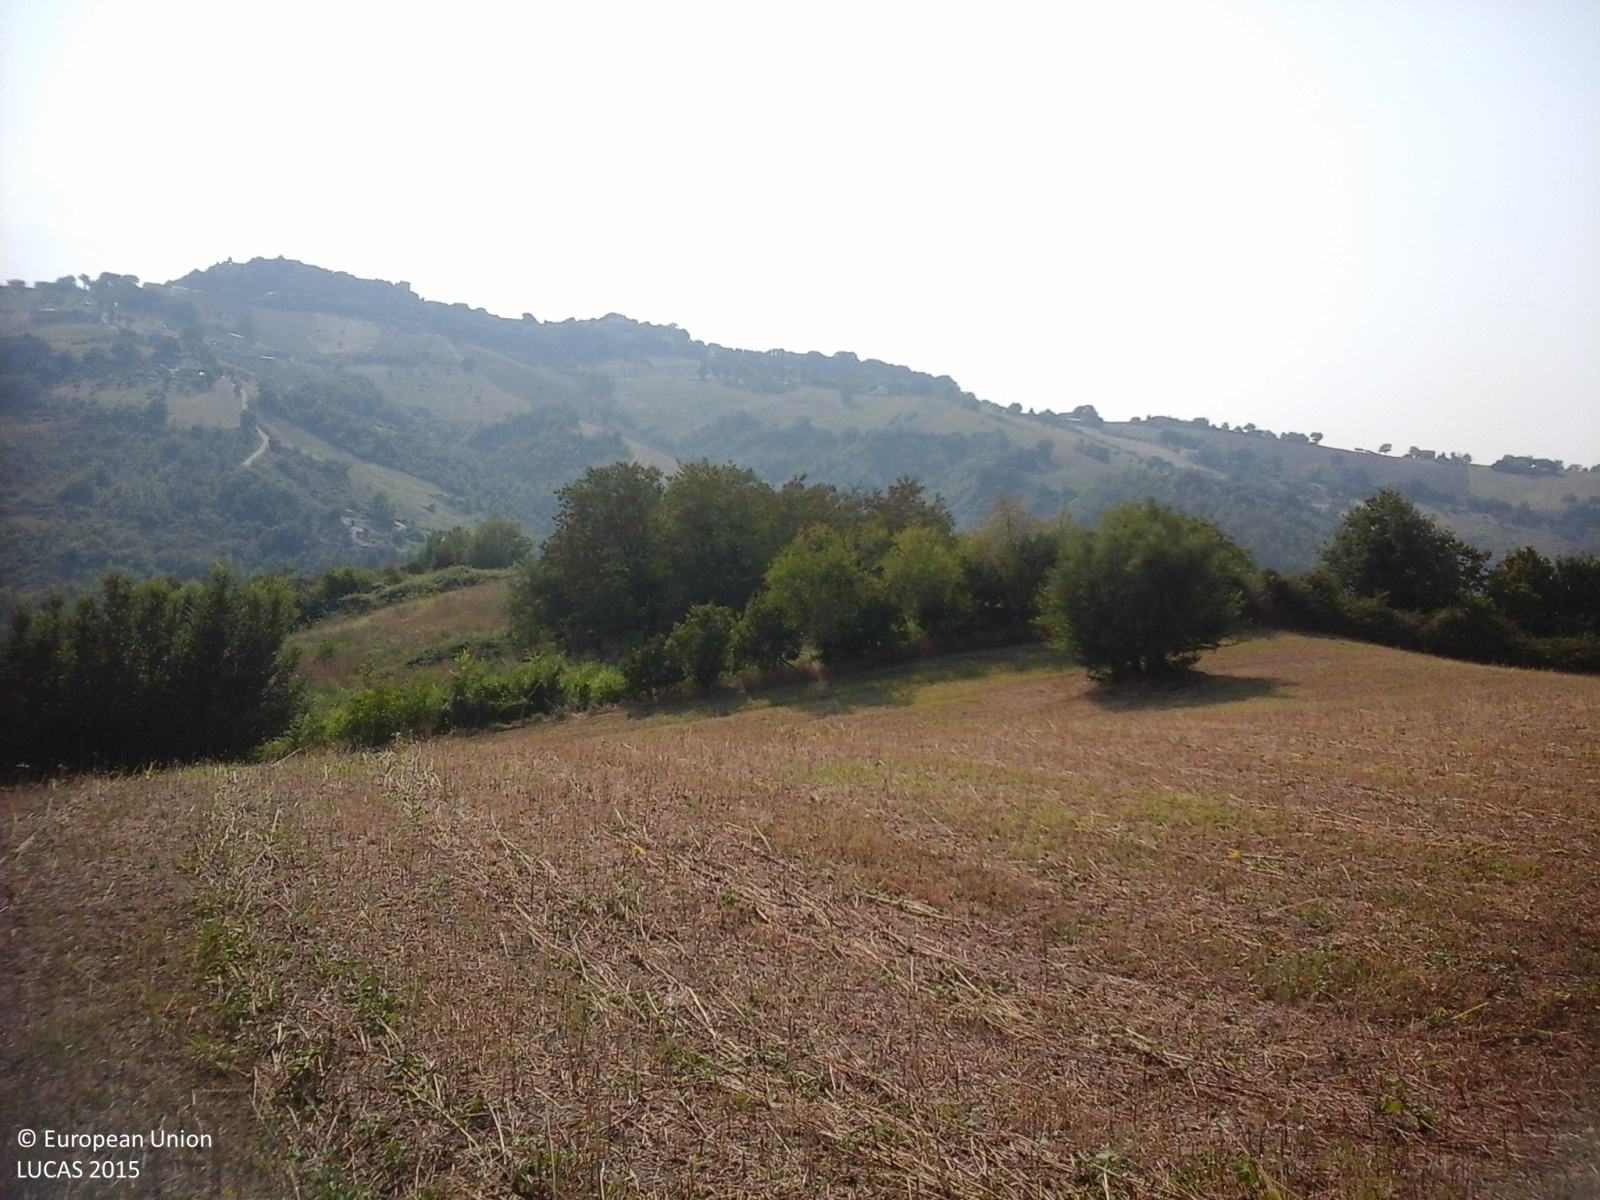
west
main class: Grassland
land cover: Spontaneously vegetated surfaces
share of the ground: > 75 %
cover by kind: herbaceous plants 100 %
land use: Fallow land
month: August
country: IT
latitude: 43.1023
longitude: 13.4189
